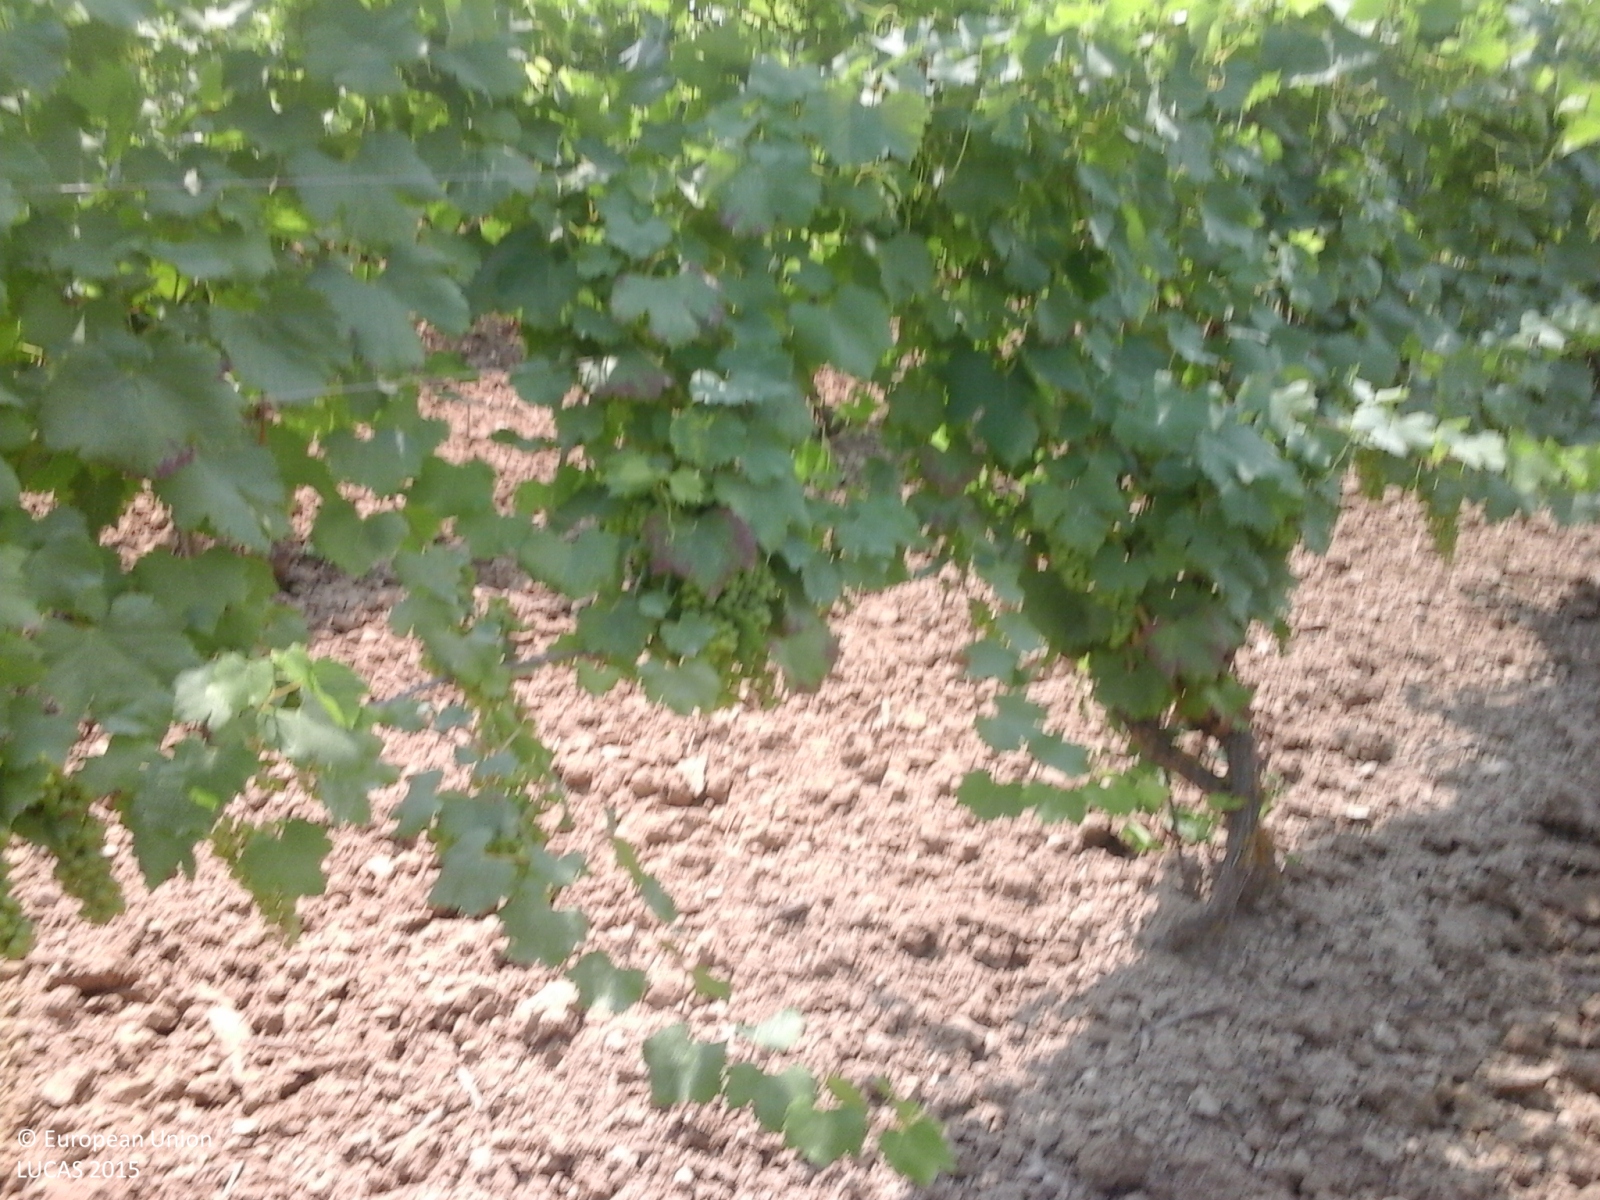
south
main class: Cropland
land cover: Vineyards
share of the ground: > 75 %
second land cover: Other bare soil
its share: > 75 %
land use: Agriculture (excluding fallow land and kitchen gardens)
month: June
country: IT
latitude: 44.9892
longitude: 8.5189
